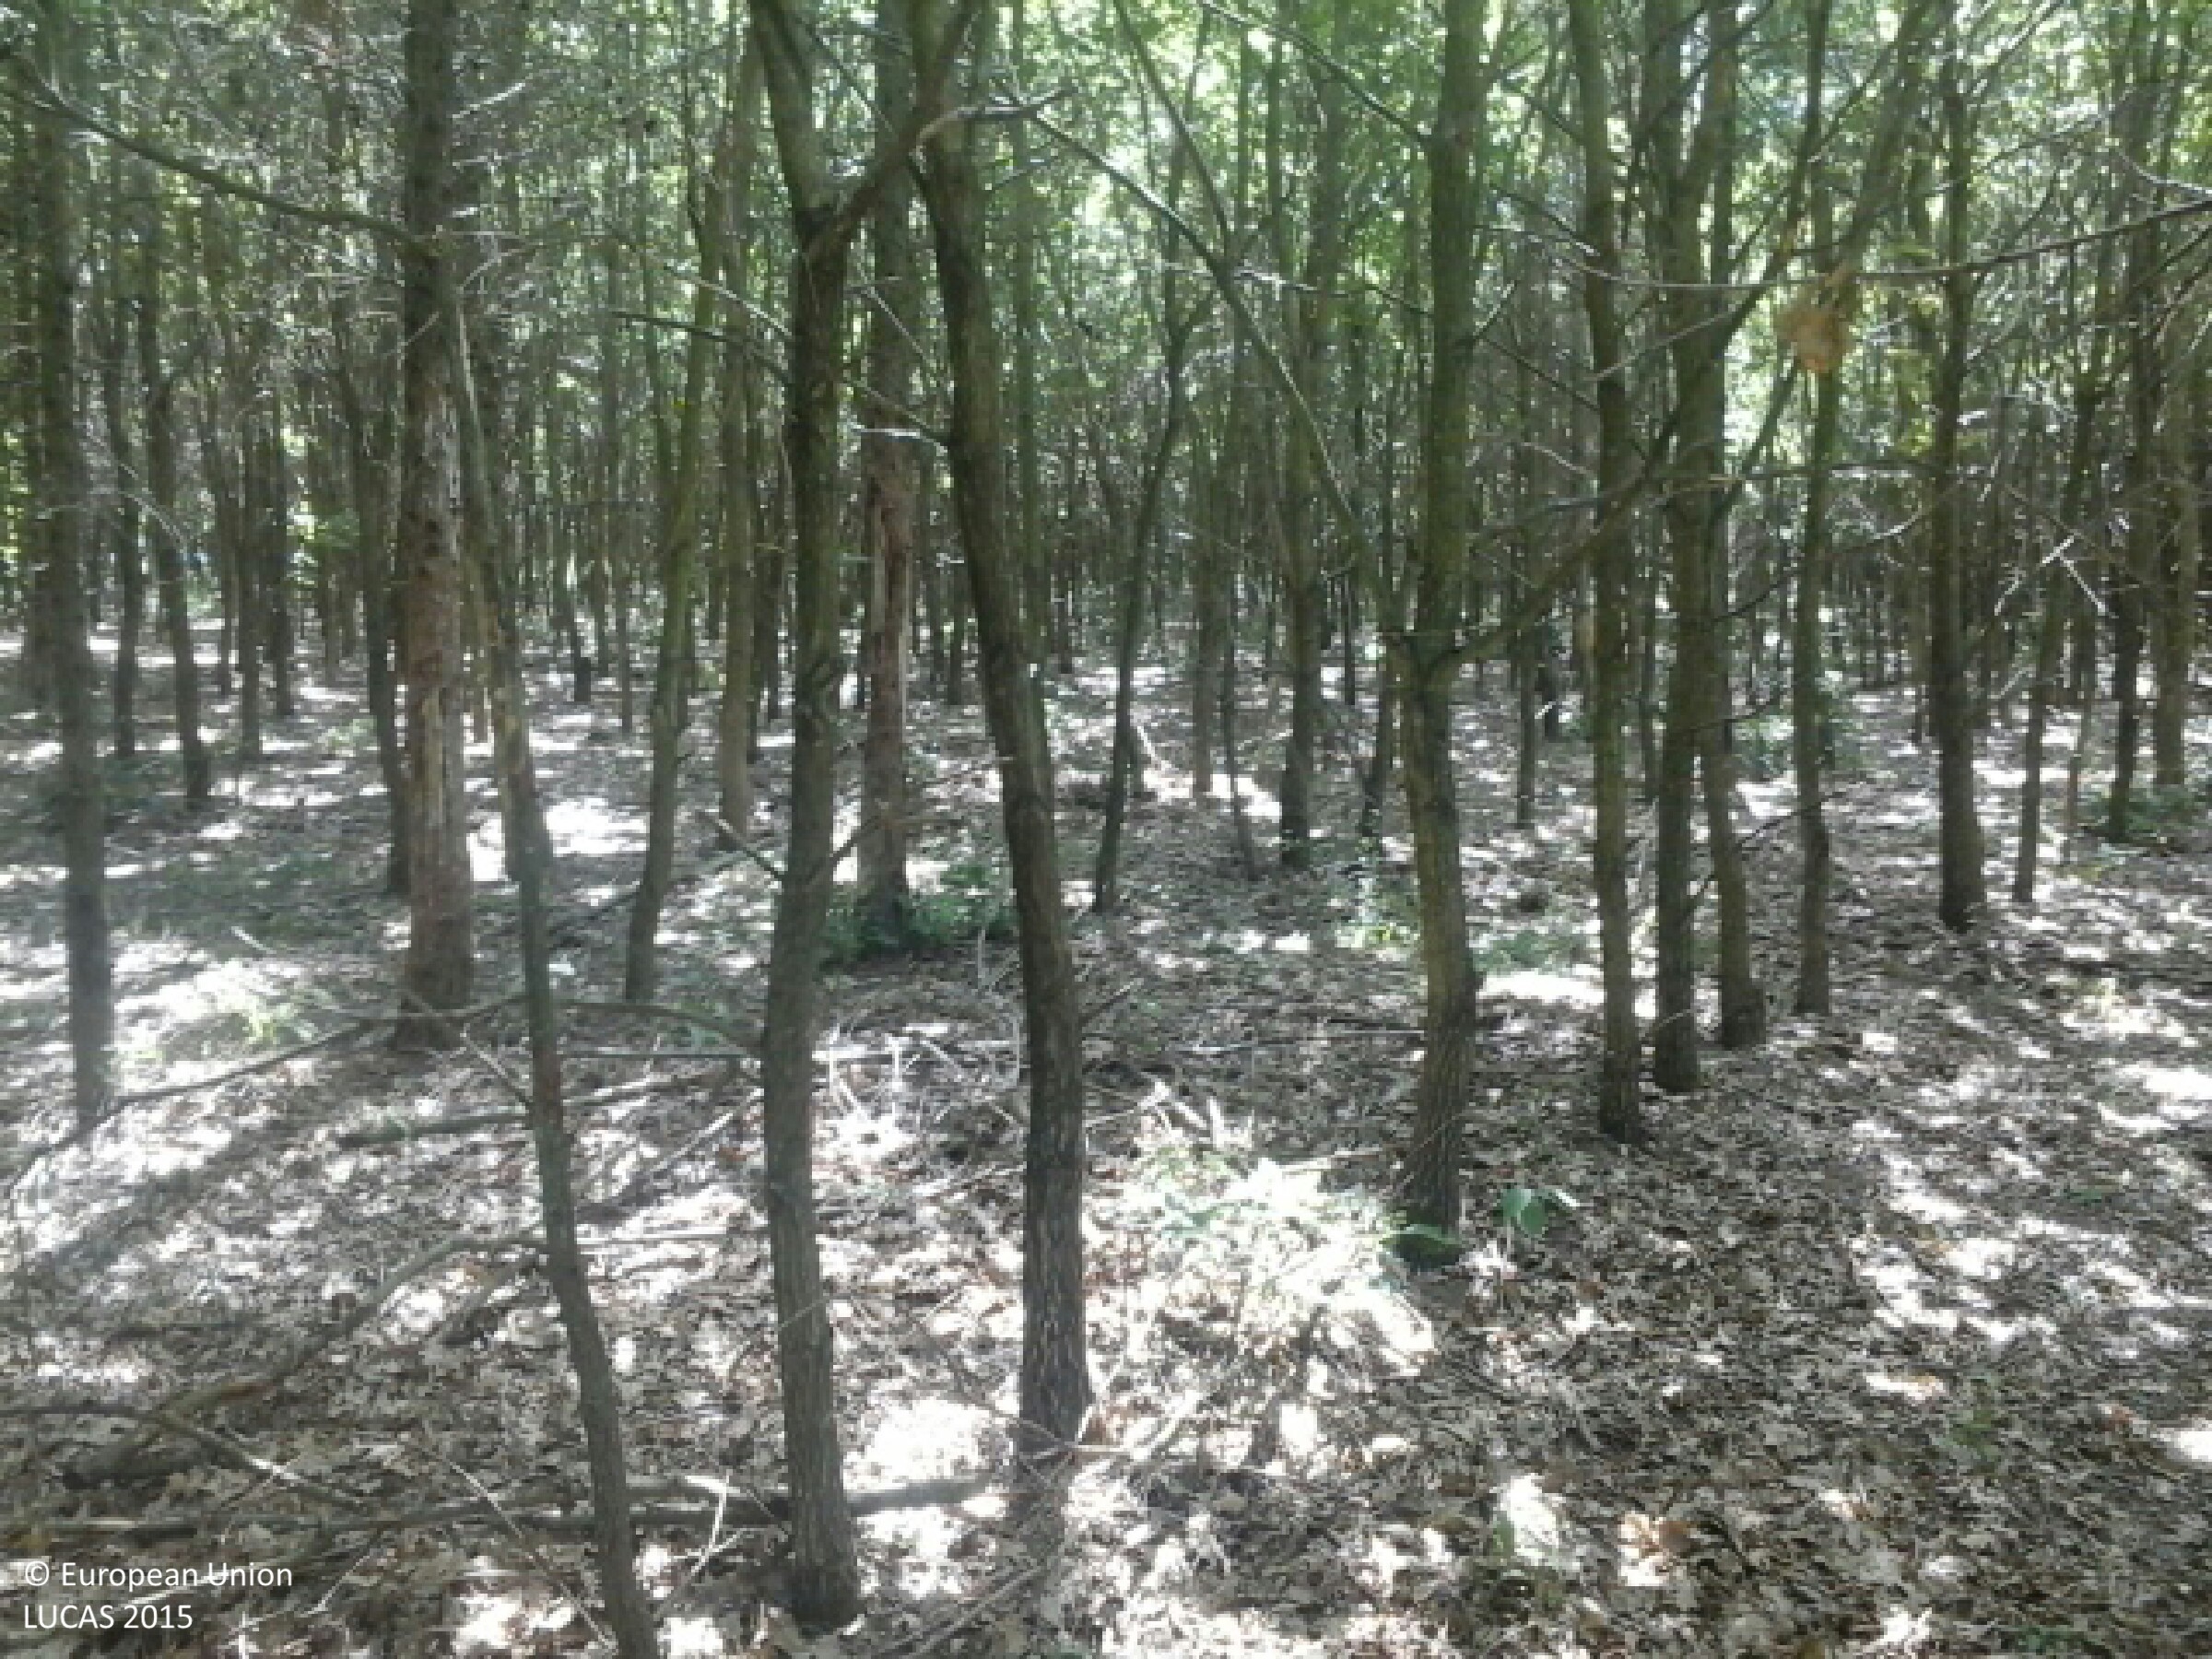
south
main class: Woodland
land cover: Broadleaved woodland
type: mesophytic deciduous forest
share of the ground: > 75 %
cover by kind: broadleaved forest trees 95 %, coniferous forest trees 5 %
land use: Forestry
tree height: > 5 m
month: July
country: HU
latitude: 48.4442
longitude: 21.6069
